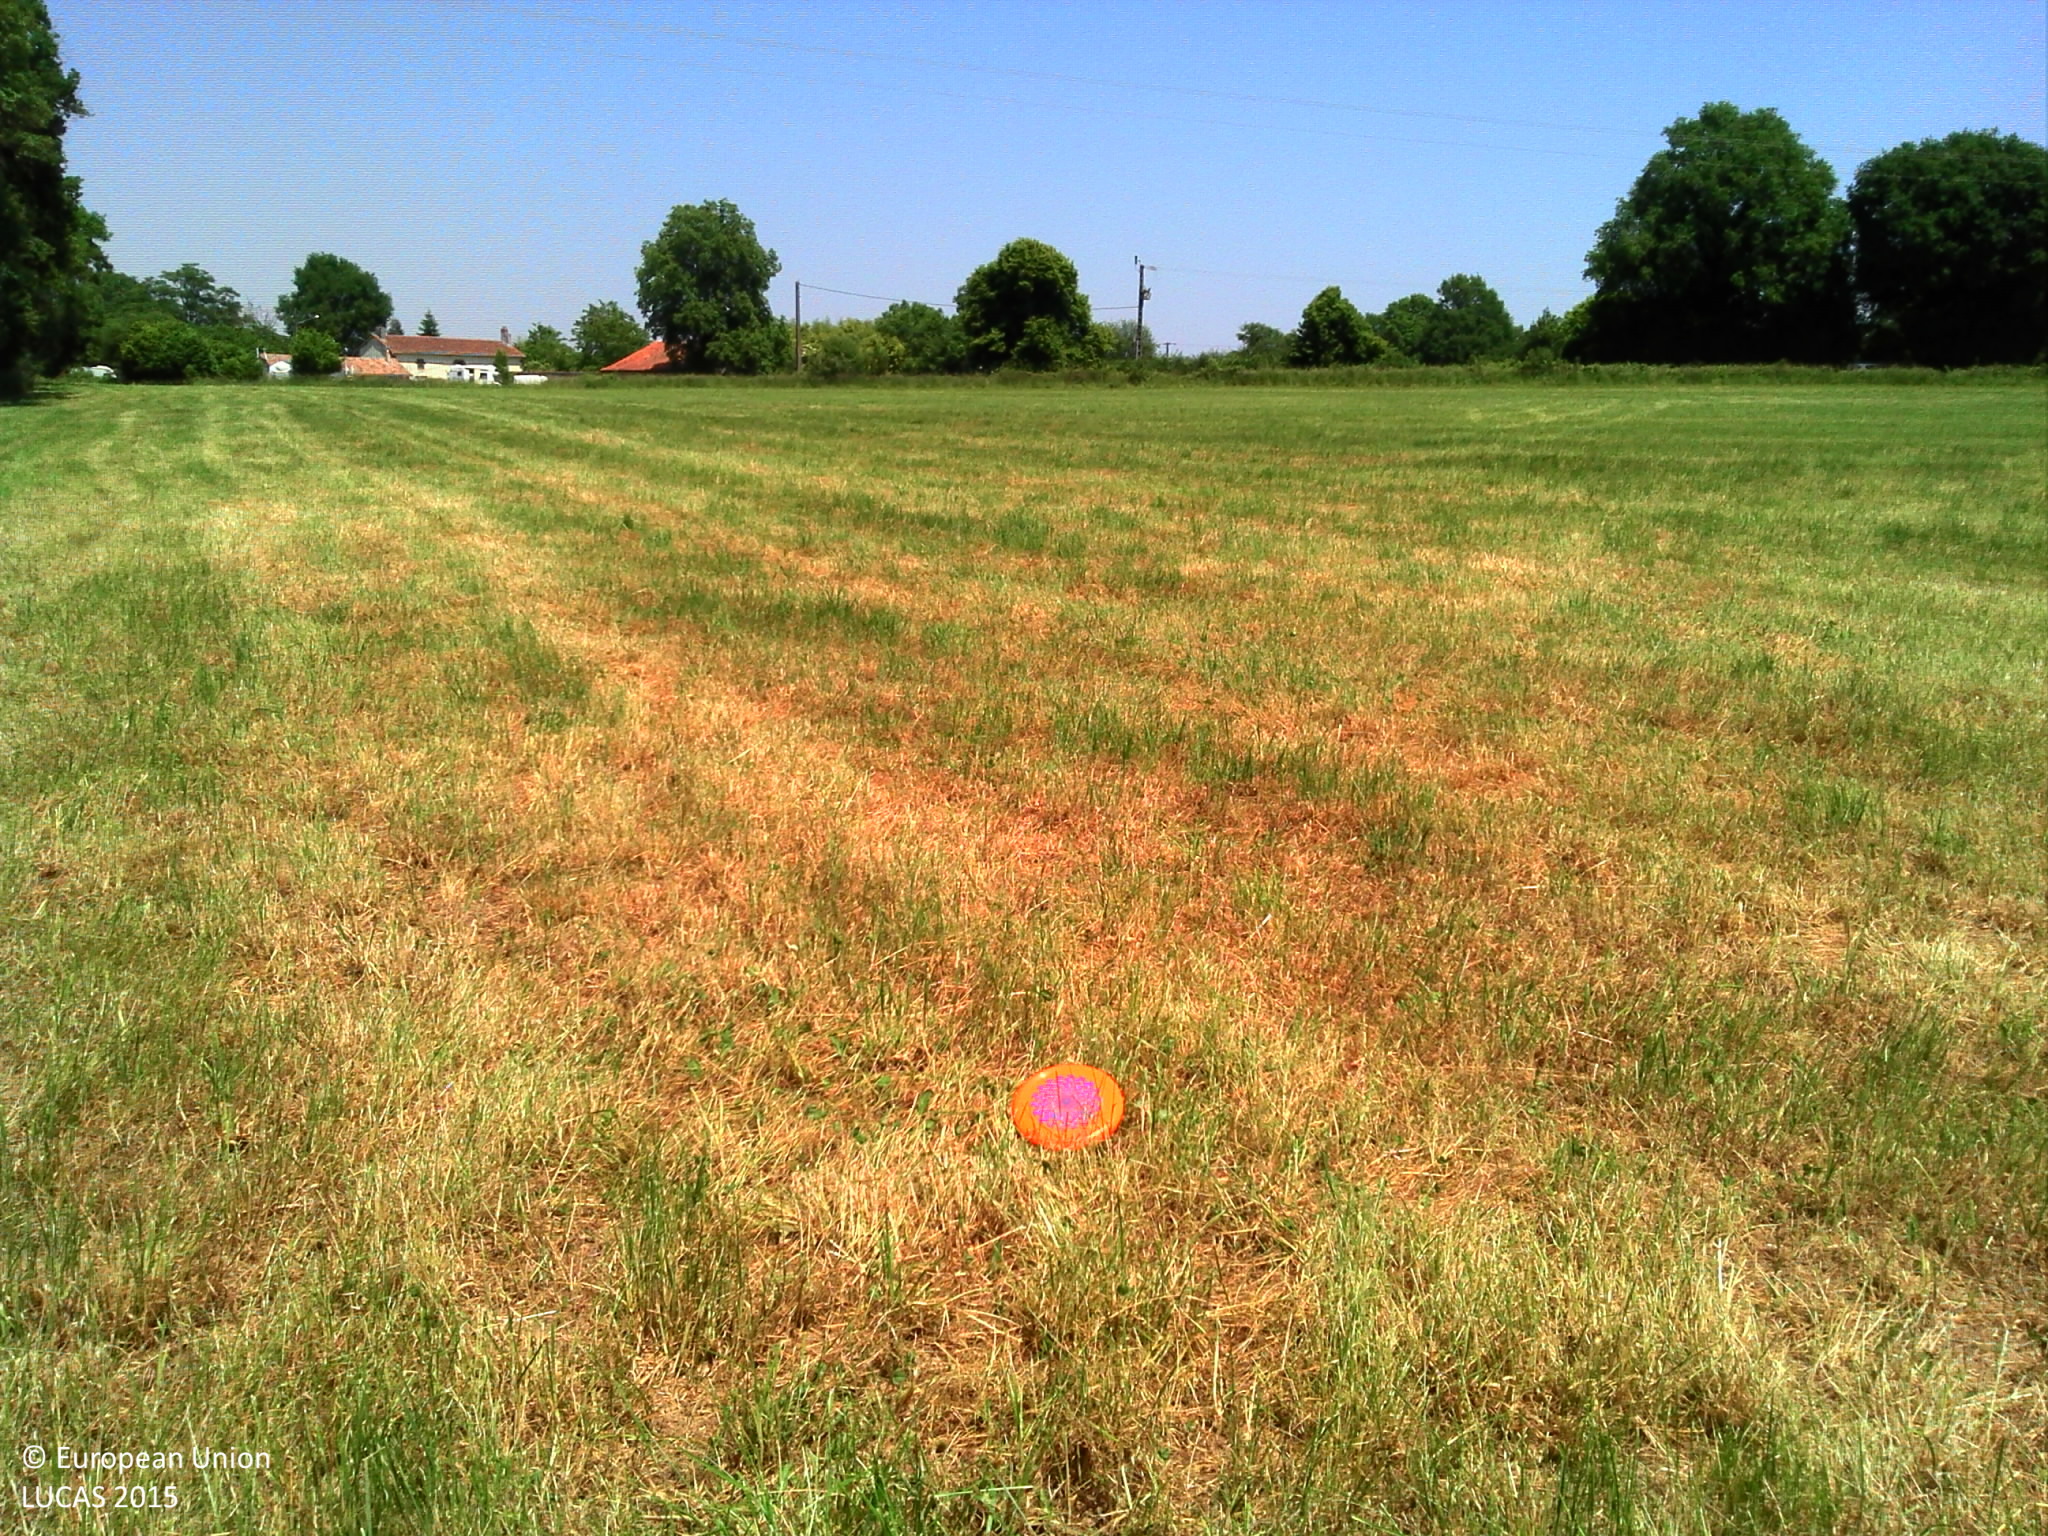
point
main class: Grassland
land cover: Grassland without tree/shrub cover
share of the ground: > 75 %
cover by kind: herbaceous plants 100 %
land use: Agriculture (excluding fallow land and kitchen gardens)
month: June
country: FR
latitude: 46.0778
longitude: 0.5585
